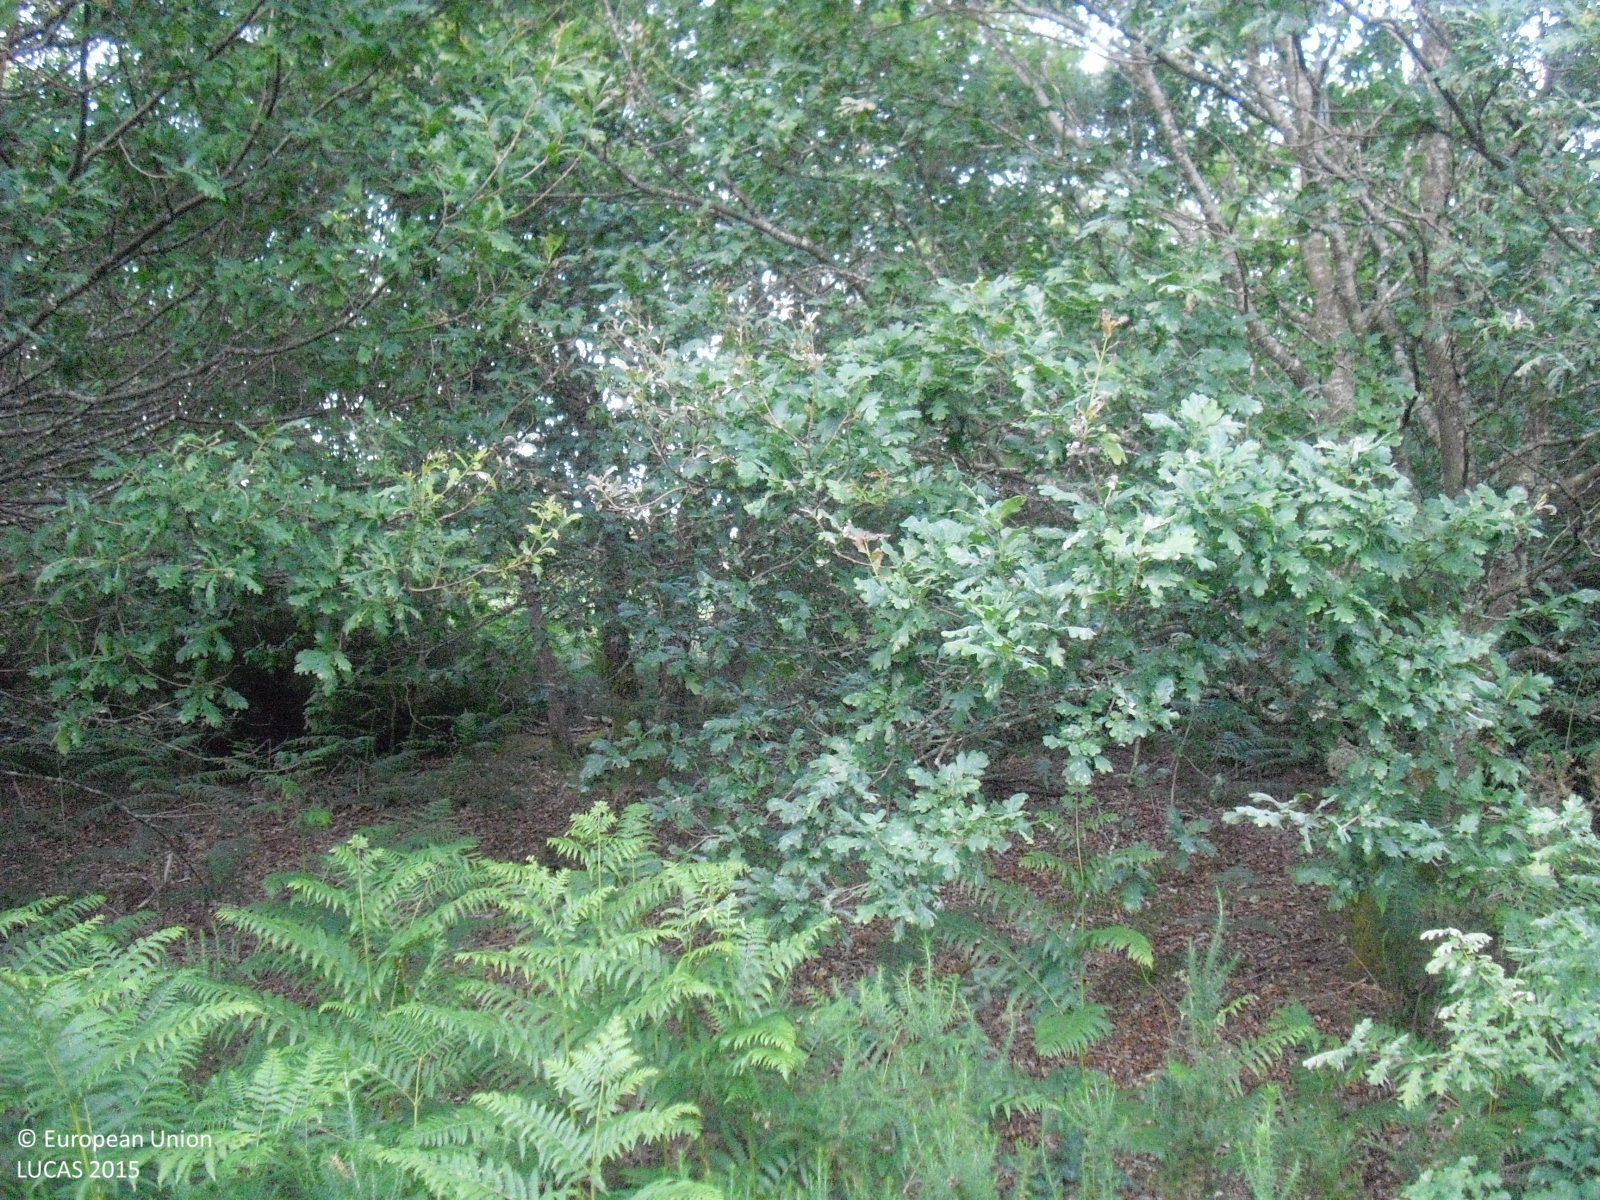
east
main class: Woodland
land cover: Broadleaved woodland
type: thermophilous deciduous forest
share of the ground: 50 - 75 %
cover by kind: broadleaved forest trees 60 %, shrubs 30 %, herbaceous plants 10 %
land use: Forestry
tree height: > 5 m
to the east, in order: Broadleaved woodland; Dry stone walls; Shrubland with sparse tree cover; Rock outcrops; Broadleaved woodland; Shrubland with sparse tree cover; Ditches and canals; Paved roads, cycling and walking lanes; Ditches and canals; Shruby margins; Pine dominated coniferous woodland; Broadleaved woodland
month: June
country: ES
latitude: 42.5571
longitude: -7.8999
